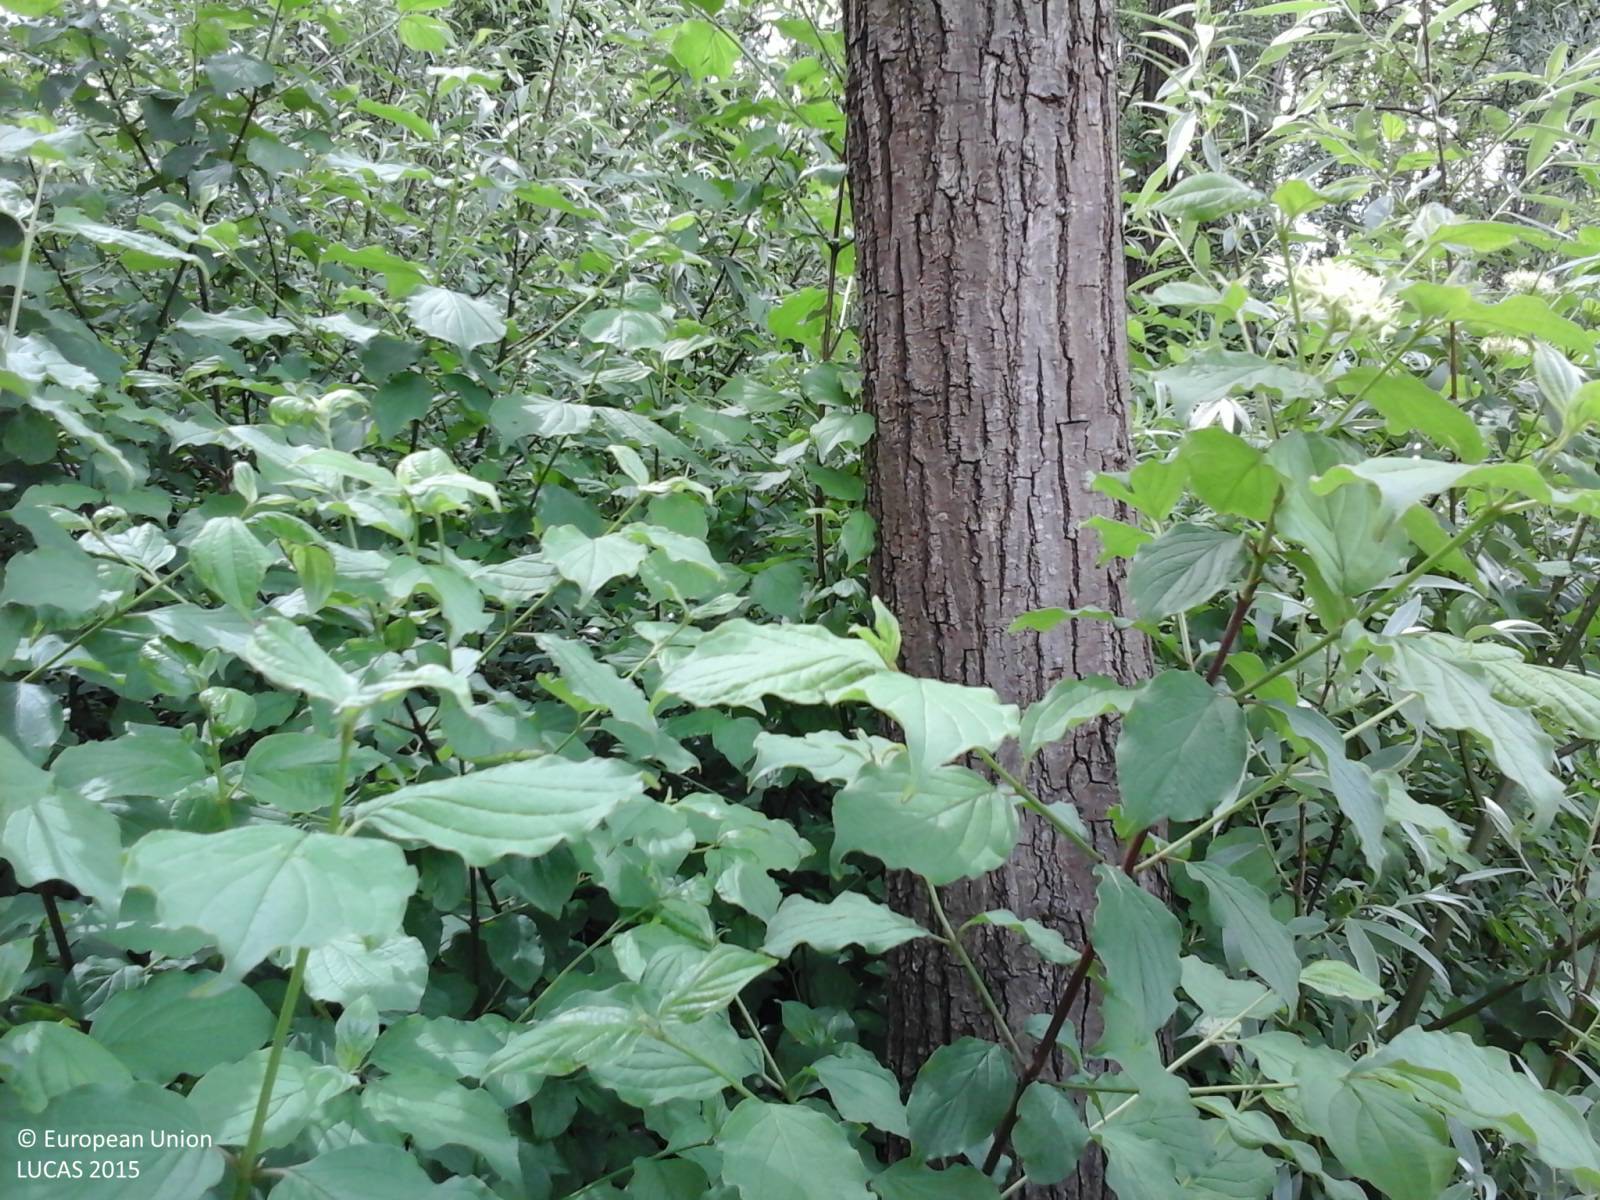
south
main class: Woodland
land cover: Broadleaved woodland
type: floodplain forest
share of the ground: > 75 %
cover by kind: broadleaved forest trees 80 %, shrubs 20 %
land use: Forestry
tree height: > 5 m
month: May
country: IT
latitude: 46.1991
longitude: 13.0679
